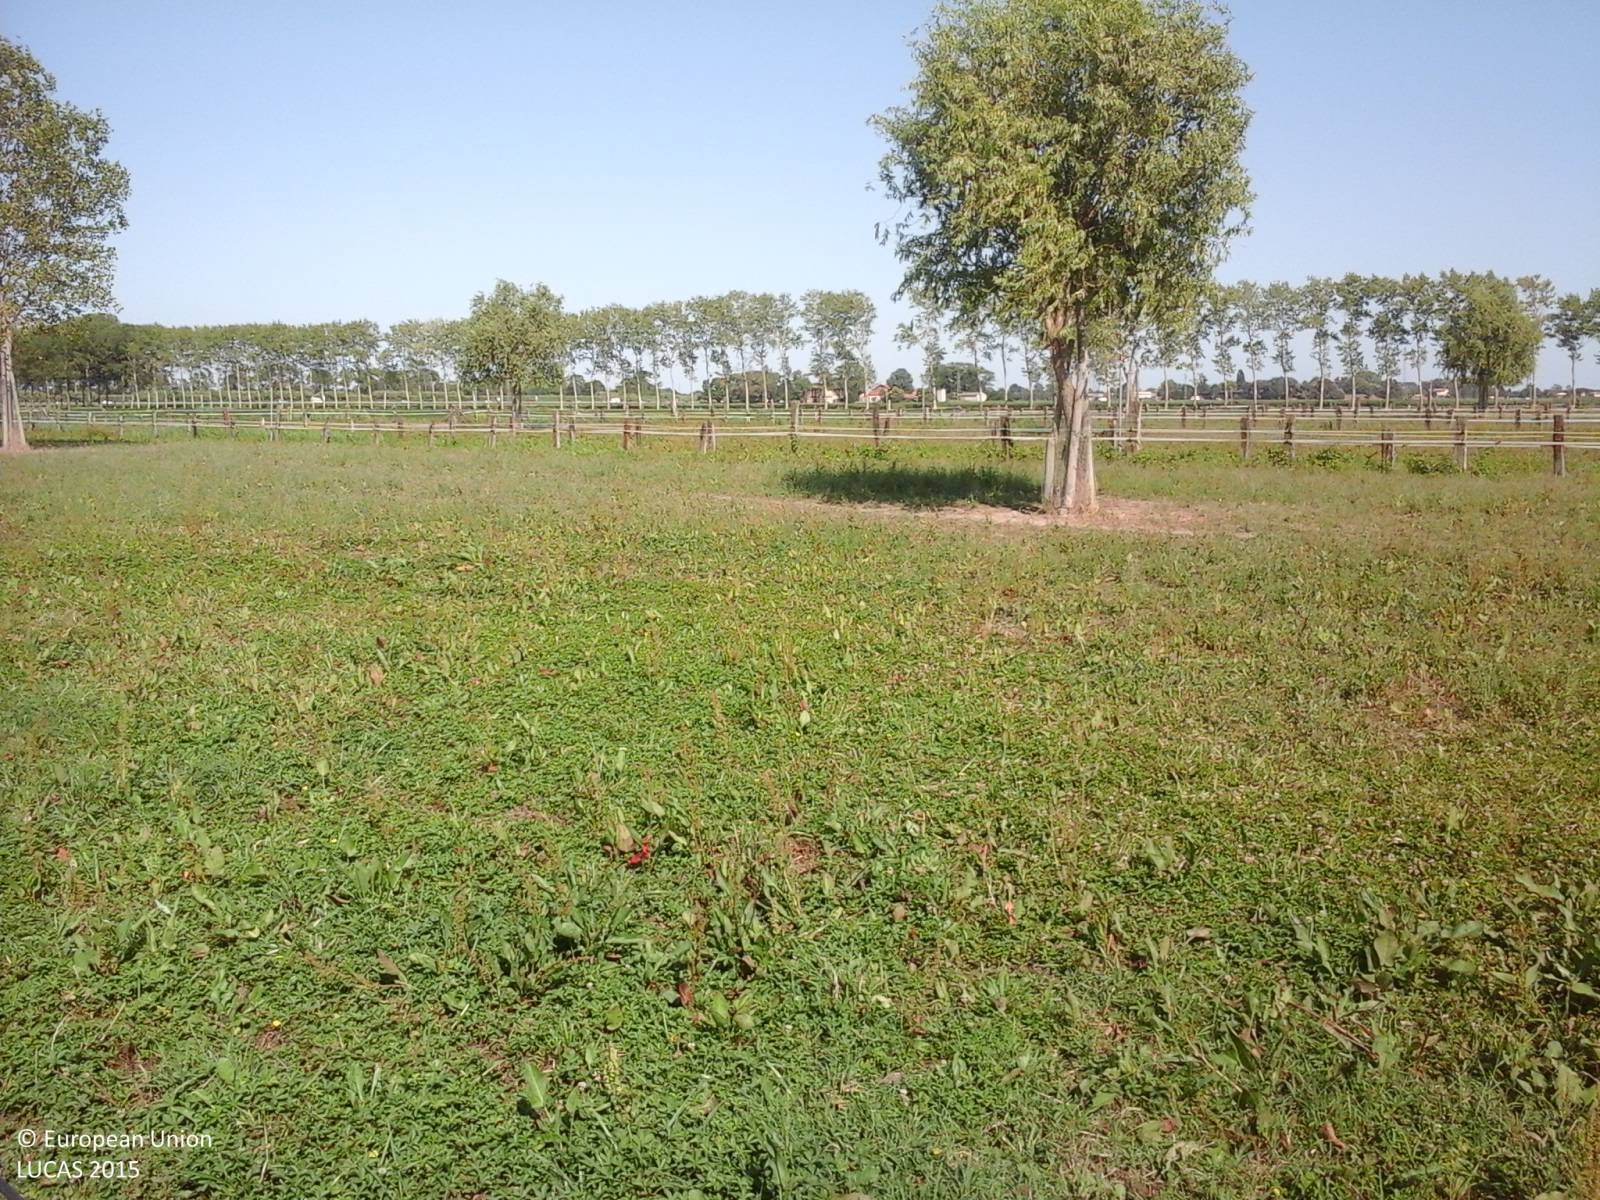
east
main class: Grassland
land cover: Grassland without tree/shrub cover
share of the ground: > 75 %
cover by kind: herbaceous plants 100 %
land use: Agriculture (excluding fallow land and kitchen gardens)
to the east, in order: Grassland without tree/shrub cover; Fences; Ditches and canals; Fences; Grassland without tree/shrub cover; Fences; Ditches and canals; Fences; Grassland without tree/shrub cover; Fences; Grass margins; Paved roads, cycling and walking lanes; Grass margins; Ditches and canals; Grass margins; Tracks; Soya; Ditches and canals; Soya; Ditches and canals; Soya
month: July
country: IT
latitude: 45.6771
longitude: 13.0386
